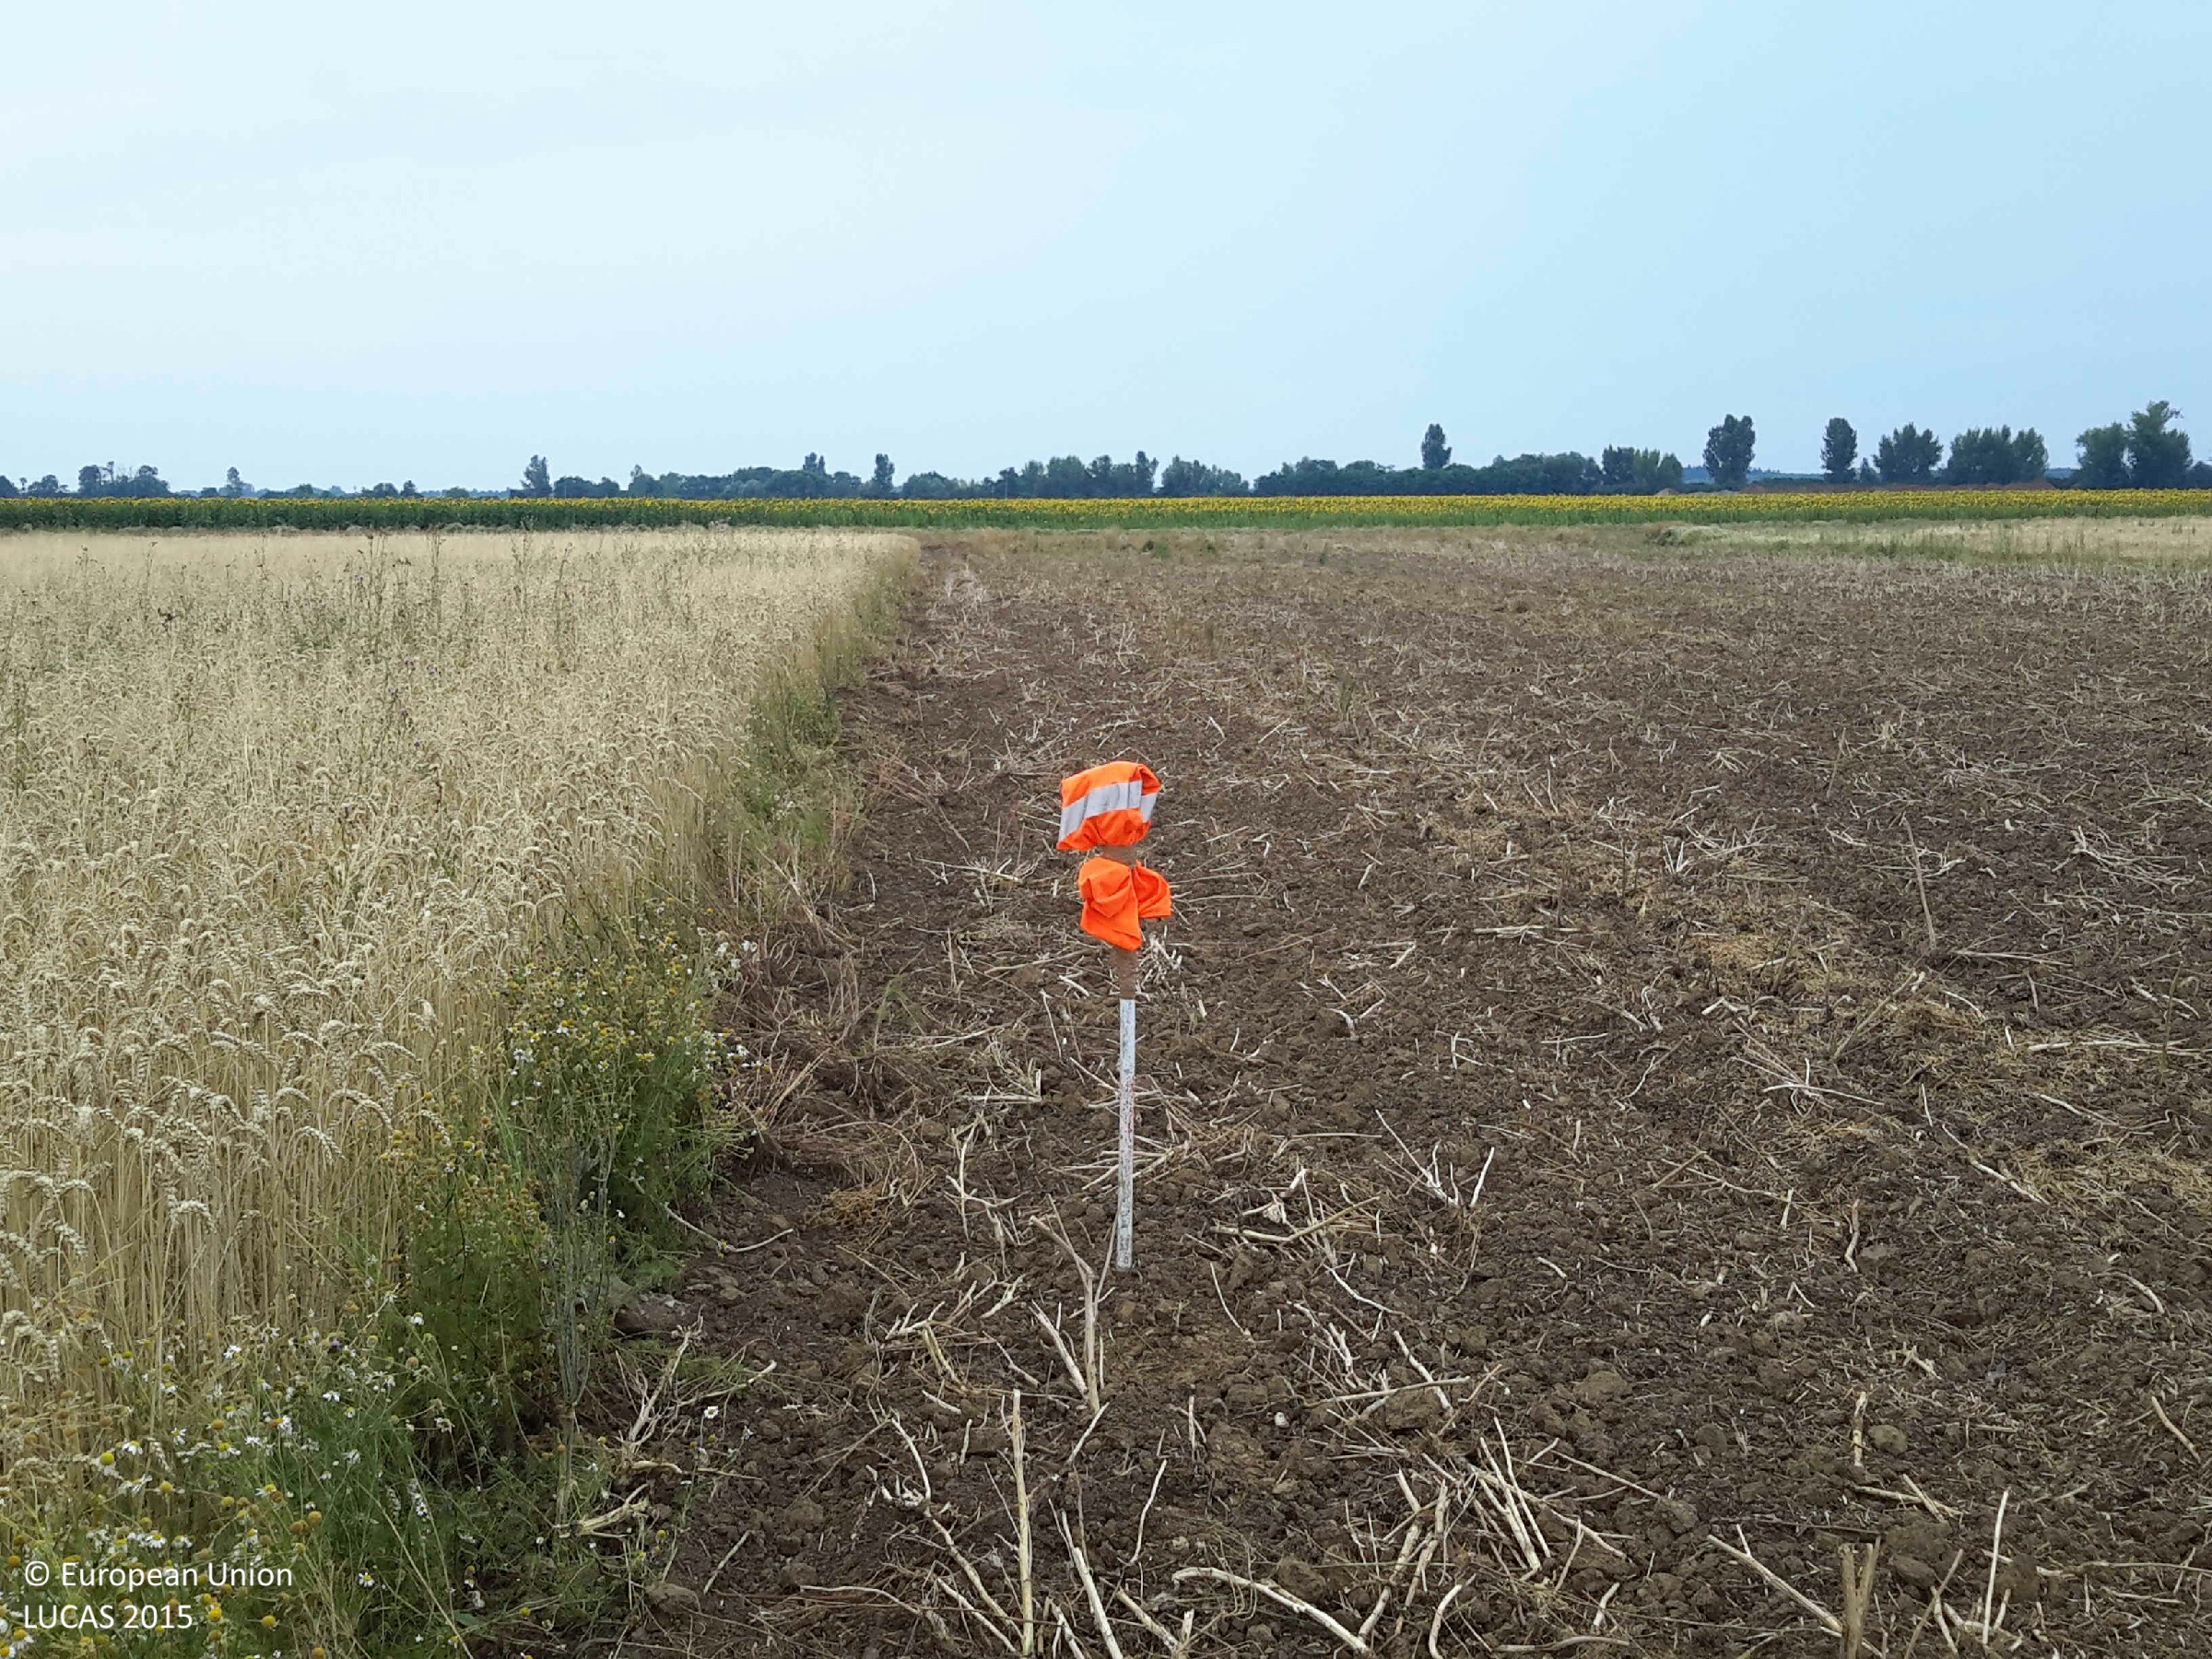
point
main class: Cropland
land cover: Common wheat
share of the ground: > 75 %
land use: Agriculture (excluding fallow land and kitchen gardens)
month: July
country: HU
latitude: 47.4362
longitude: 17.0730
